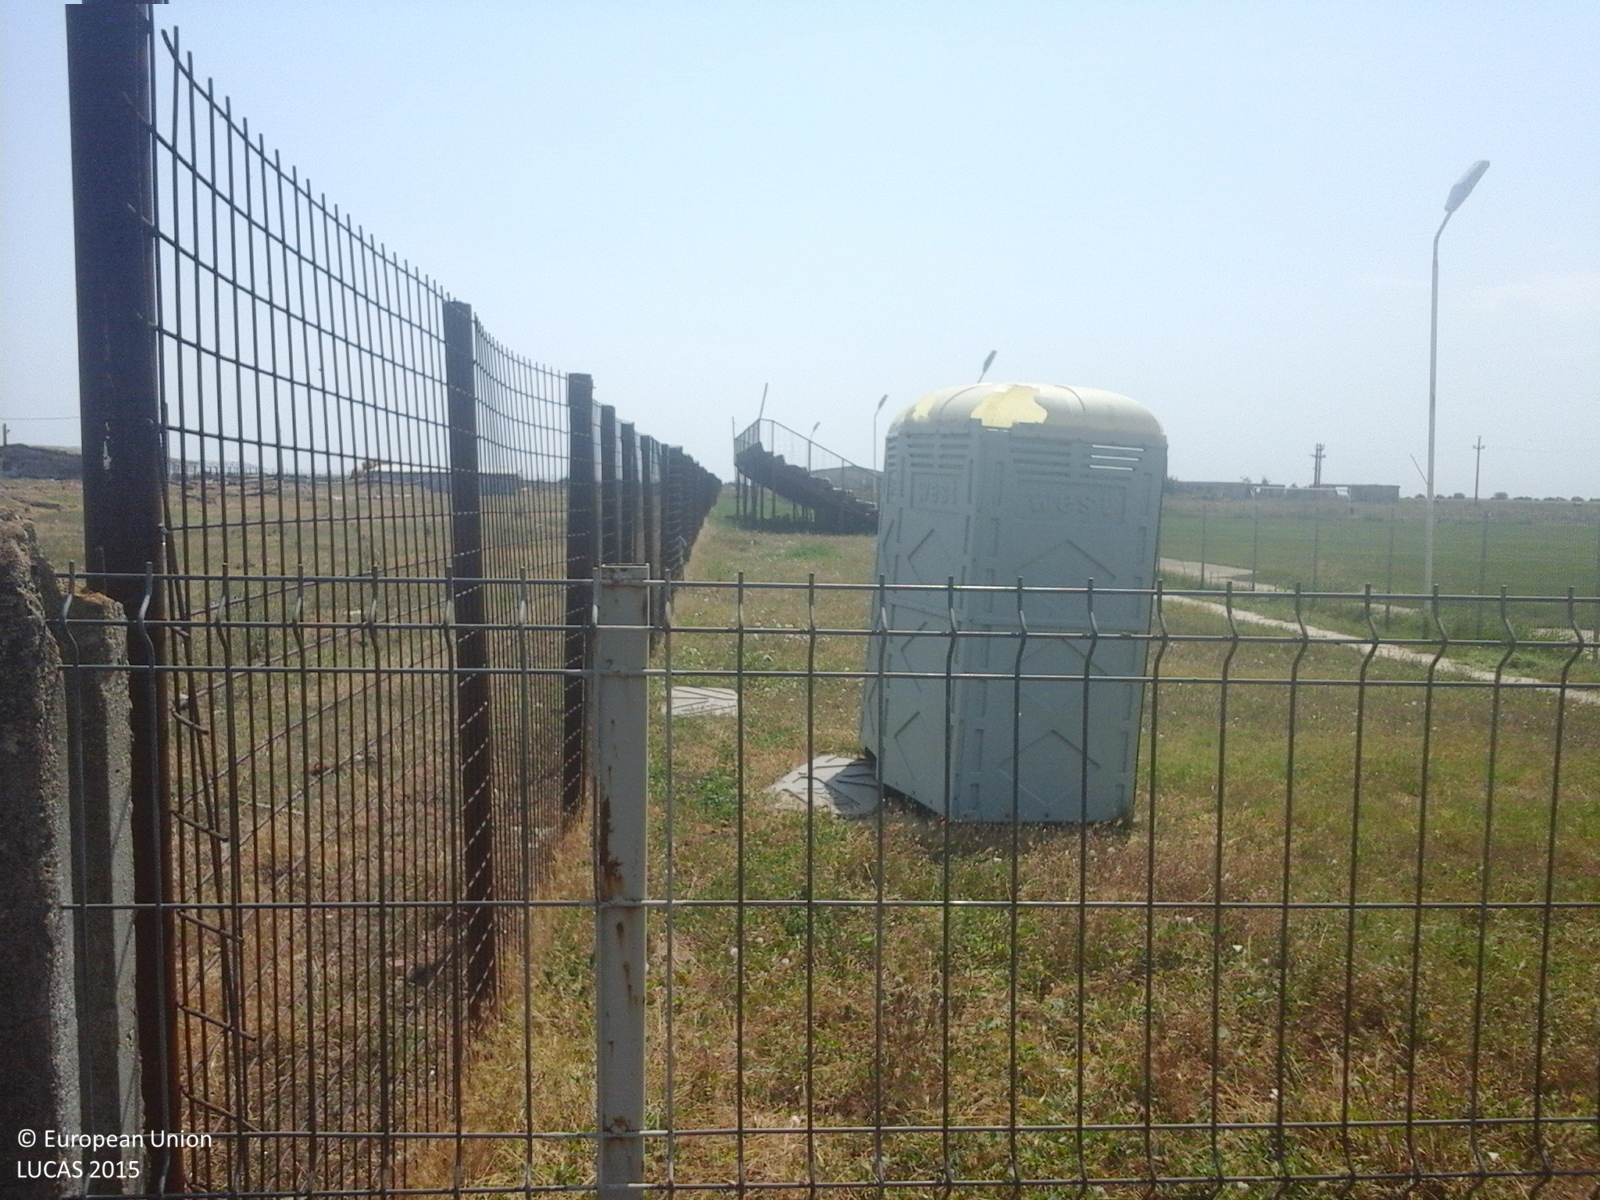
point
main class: Grassland
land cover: Spontaneously vegetated surfaces
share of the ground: > 75 %
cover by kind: herbaceous plants 100 %
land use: Sport
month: August
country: RO
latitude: 45.2295
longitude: 27.8003
